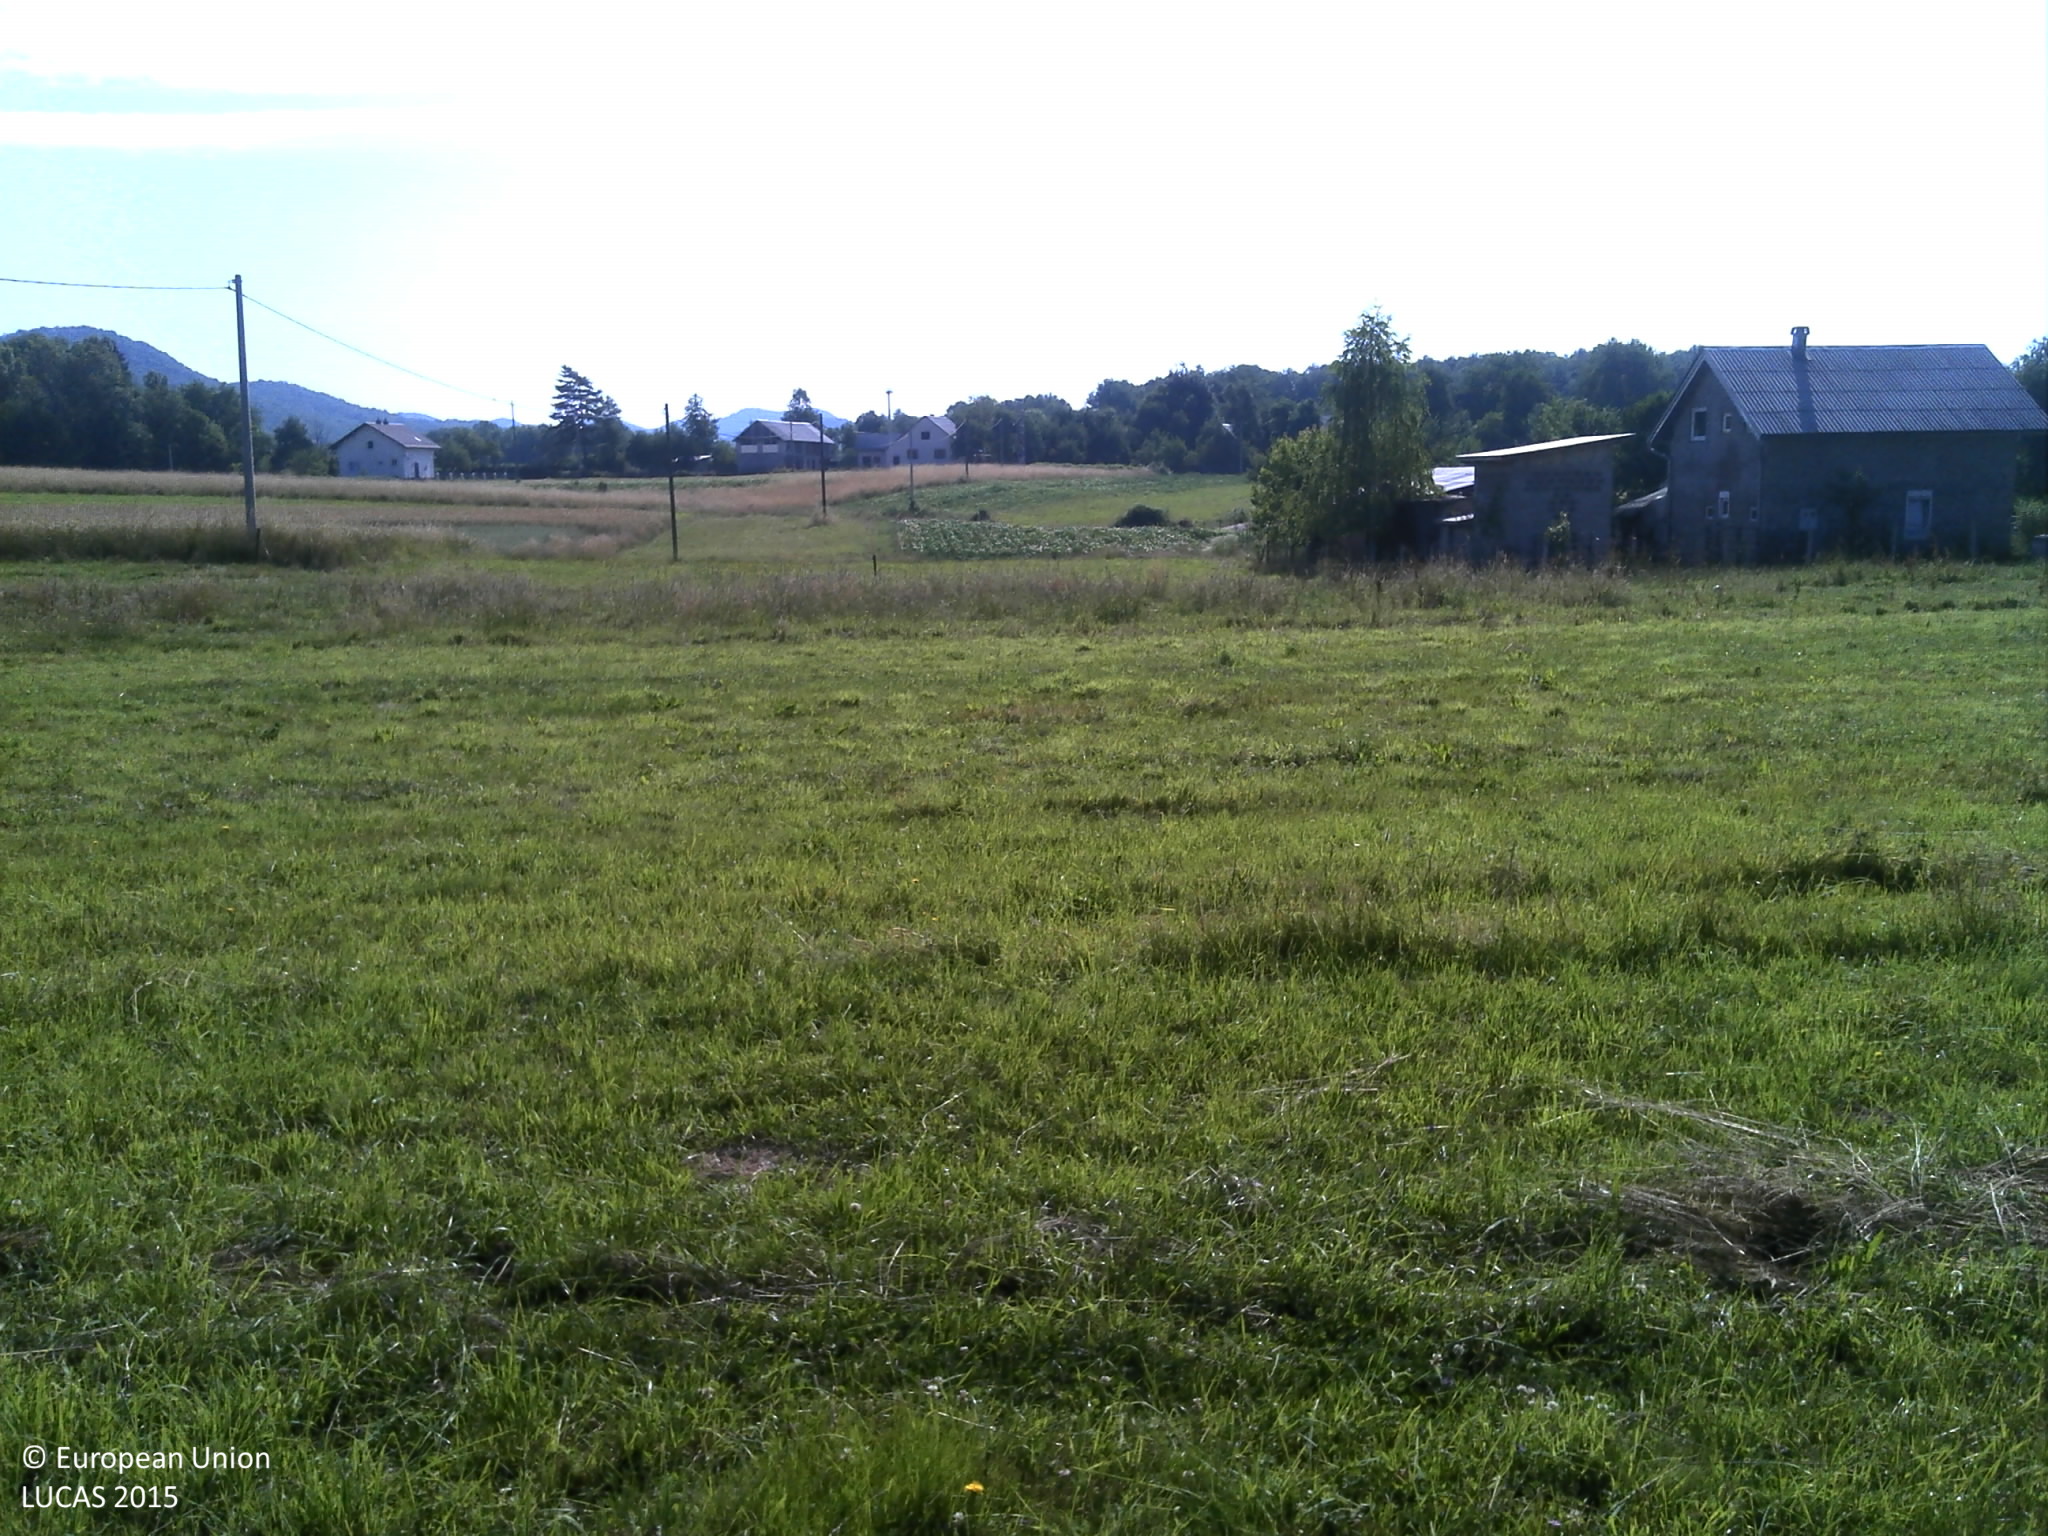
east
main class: Grassland
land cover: Grassland without tree/shrub cover
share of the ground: > 75 %
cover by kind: herbaceous plants 100 %
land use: Agriculture (excluding fallow land and kitchen gardens)
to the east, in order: Grassland without tree/shrub cover; Electric lines; Grassland without tree/shrub cover; Tracks; Fences; Grassland without tree/shrub cover; Artificial constructions in urban areas; Grassland with sparse tree/shrub cover; Tracks; Grassland with sparse tree/shrub cover; Abandoned hedges; Grassland with sparse tree/shrub cover; Lines of trees; Tracks; Grassland with sparse tree/shrub cover
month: July
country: HR
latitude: 44.6345
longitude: 15.2250
